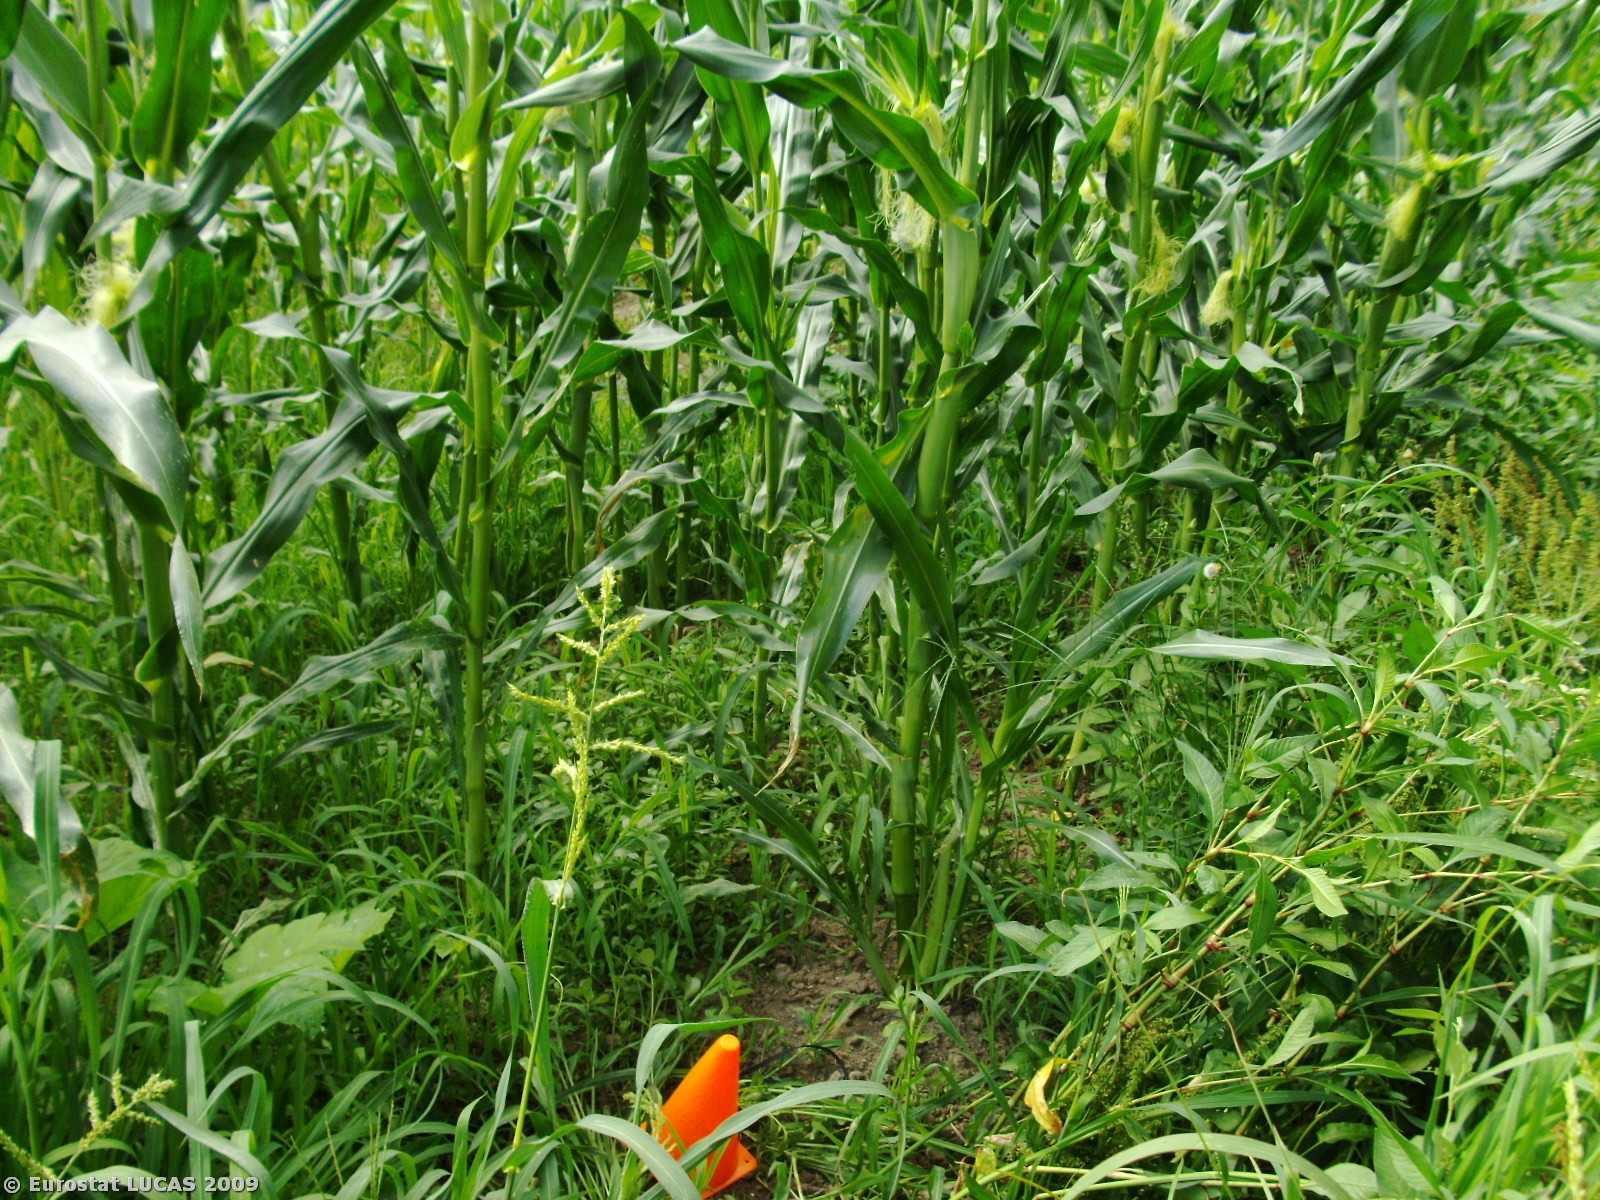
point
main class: Cropland
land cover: Maize
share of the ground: > 75 %
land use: Agriculture (excluding fallow land and kitchen gardens)
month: July
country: PT
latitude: 40.5406
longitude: -7.6244
